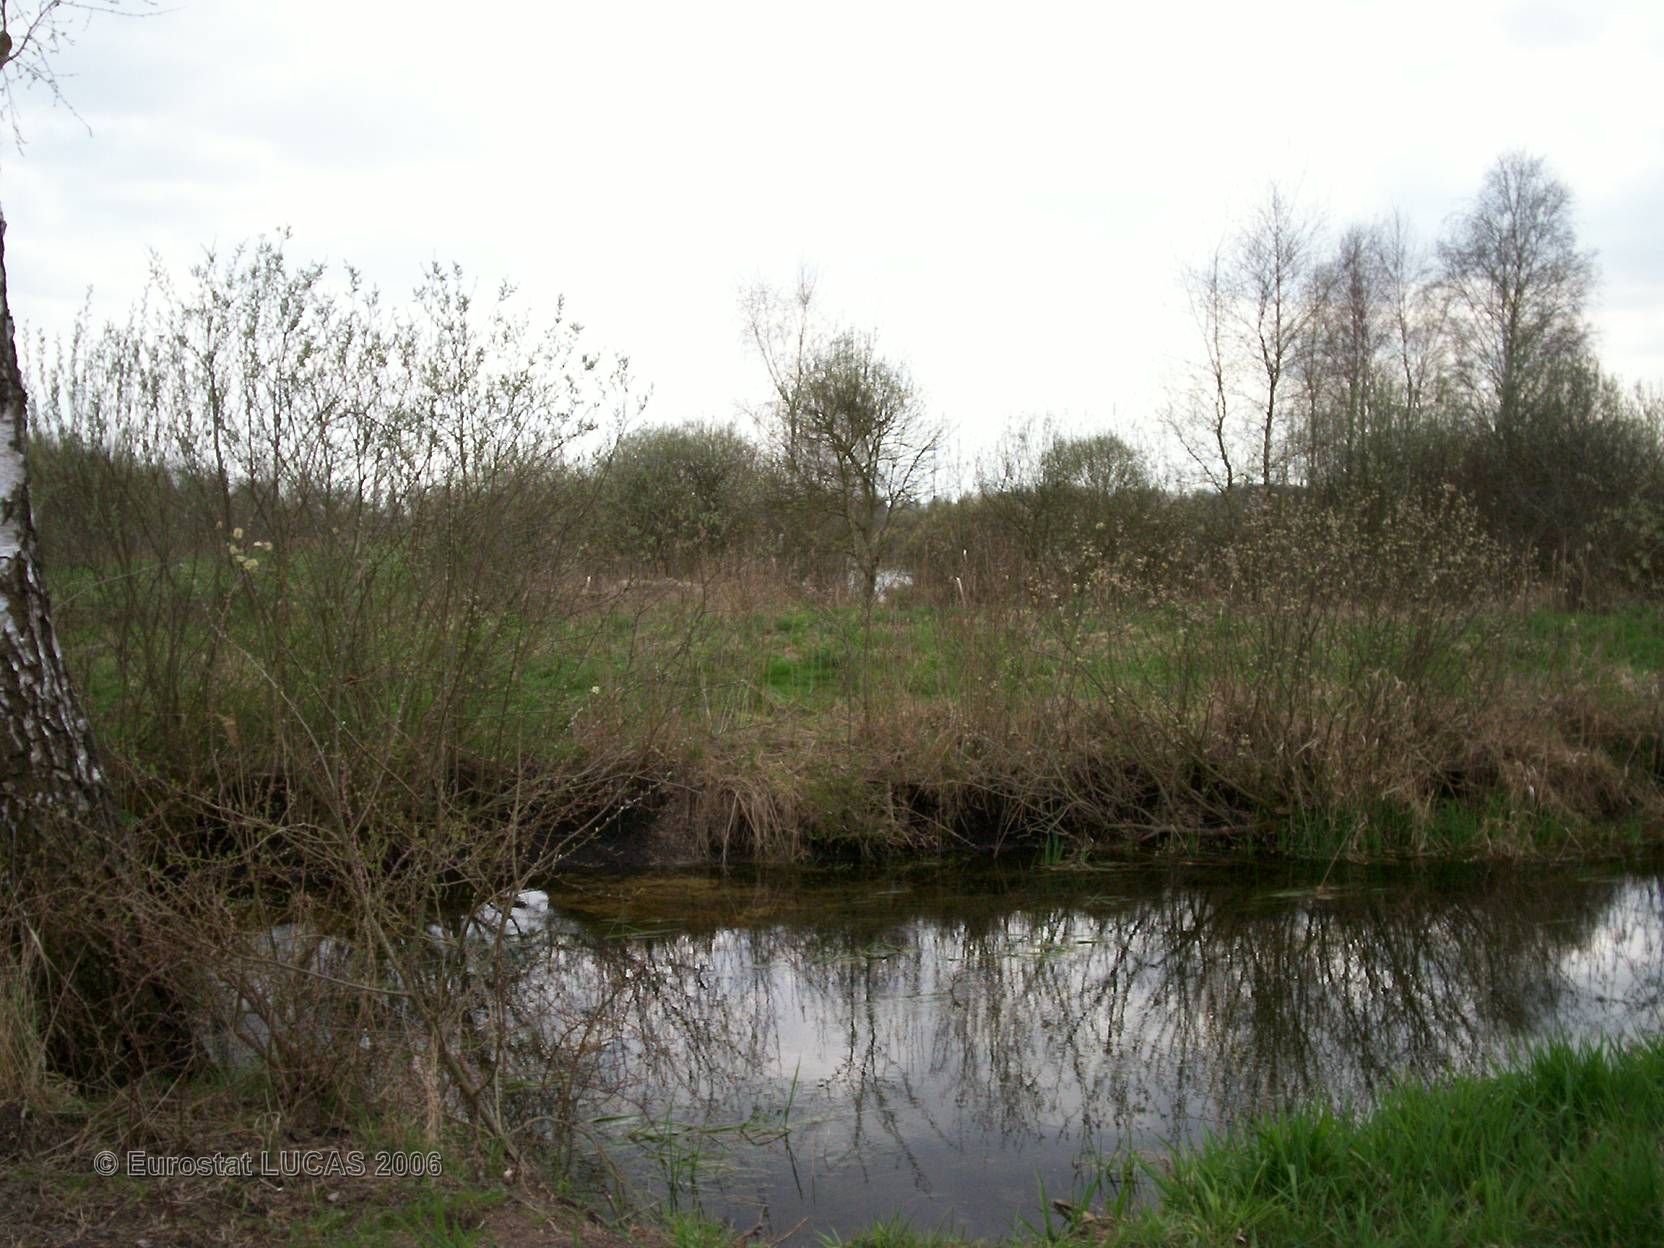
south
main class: Cropland
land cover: Maize
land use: Agriculture (excluding fallow land and kitchen gardens)
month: June
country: FR
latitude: 48.8143
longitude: 3.9350
